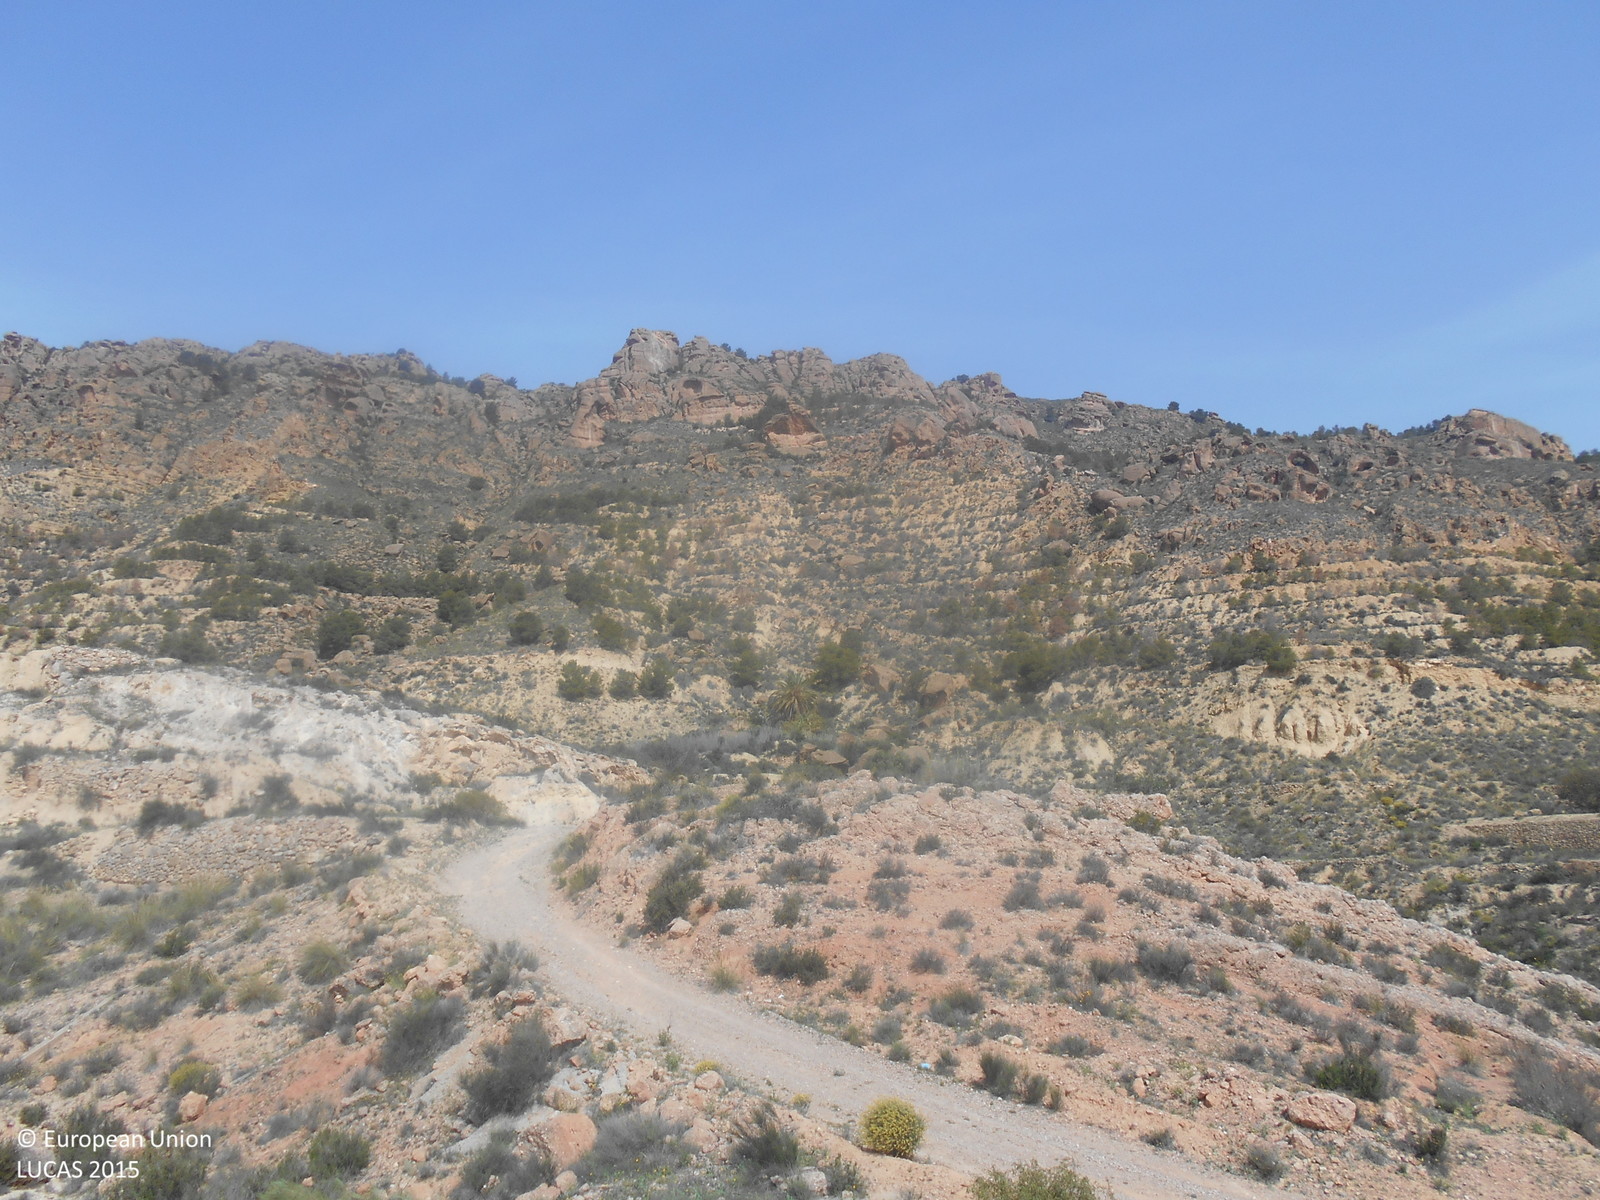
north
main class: Shrubland
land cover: Shrubland without tree cover
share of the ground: 25 - 50 %
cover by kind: shrubs 40 %, unconsolidated bare surface 40 %, herbaceous plants 20 %
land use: Semi-natural and natural areas not in use
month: April
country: ES
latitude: 37.8637
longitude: -1.4074
